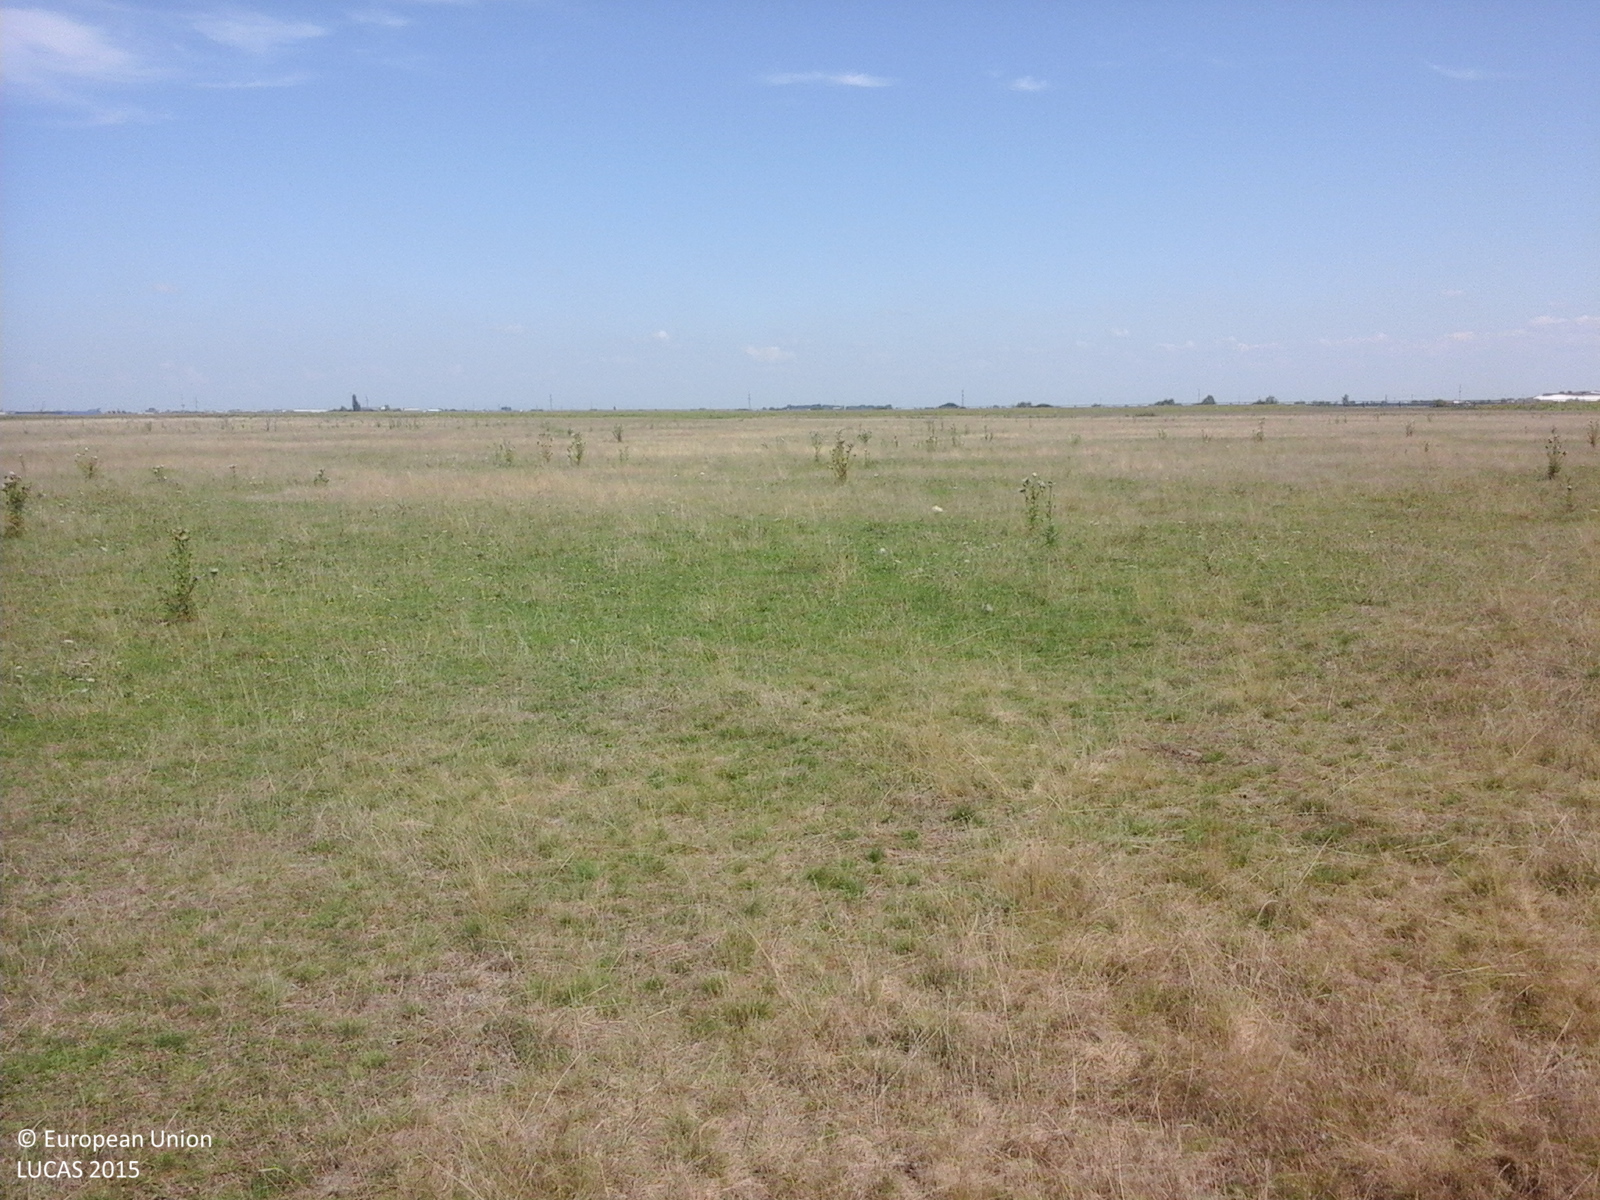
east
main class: Grassland
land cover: Grassland without tree/shrub cover
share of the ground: > 75 %
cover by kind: herbaceous plants 100 %
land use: Agriculture (excluding fallow land and kitchen gardens)
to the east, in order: Grassland without tree/shrub cover
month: August
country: RO
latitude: 45.6949
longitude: 21.1376
